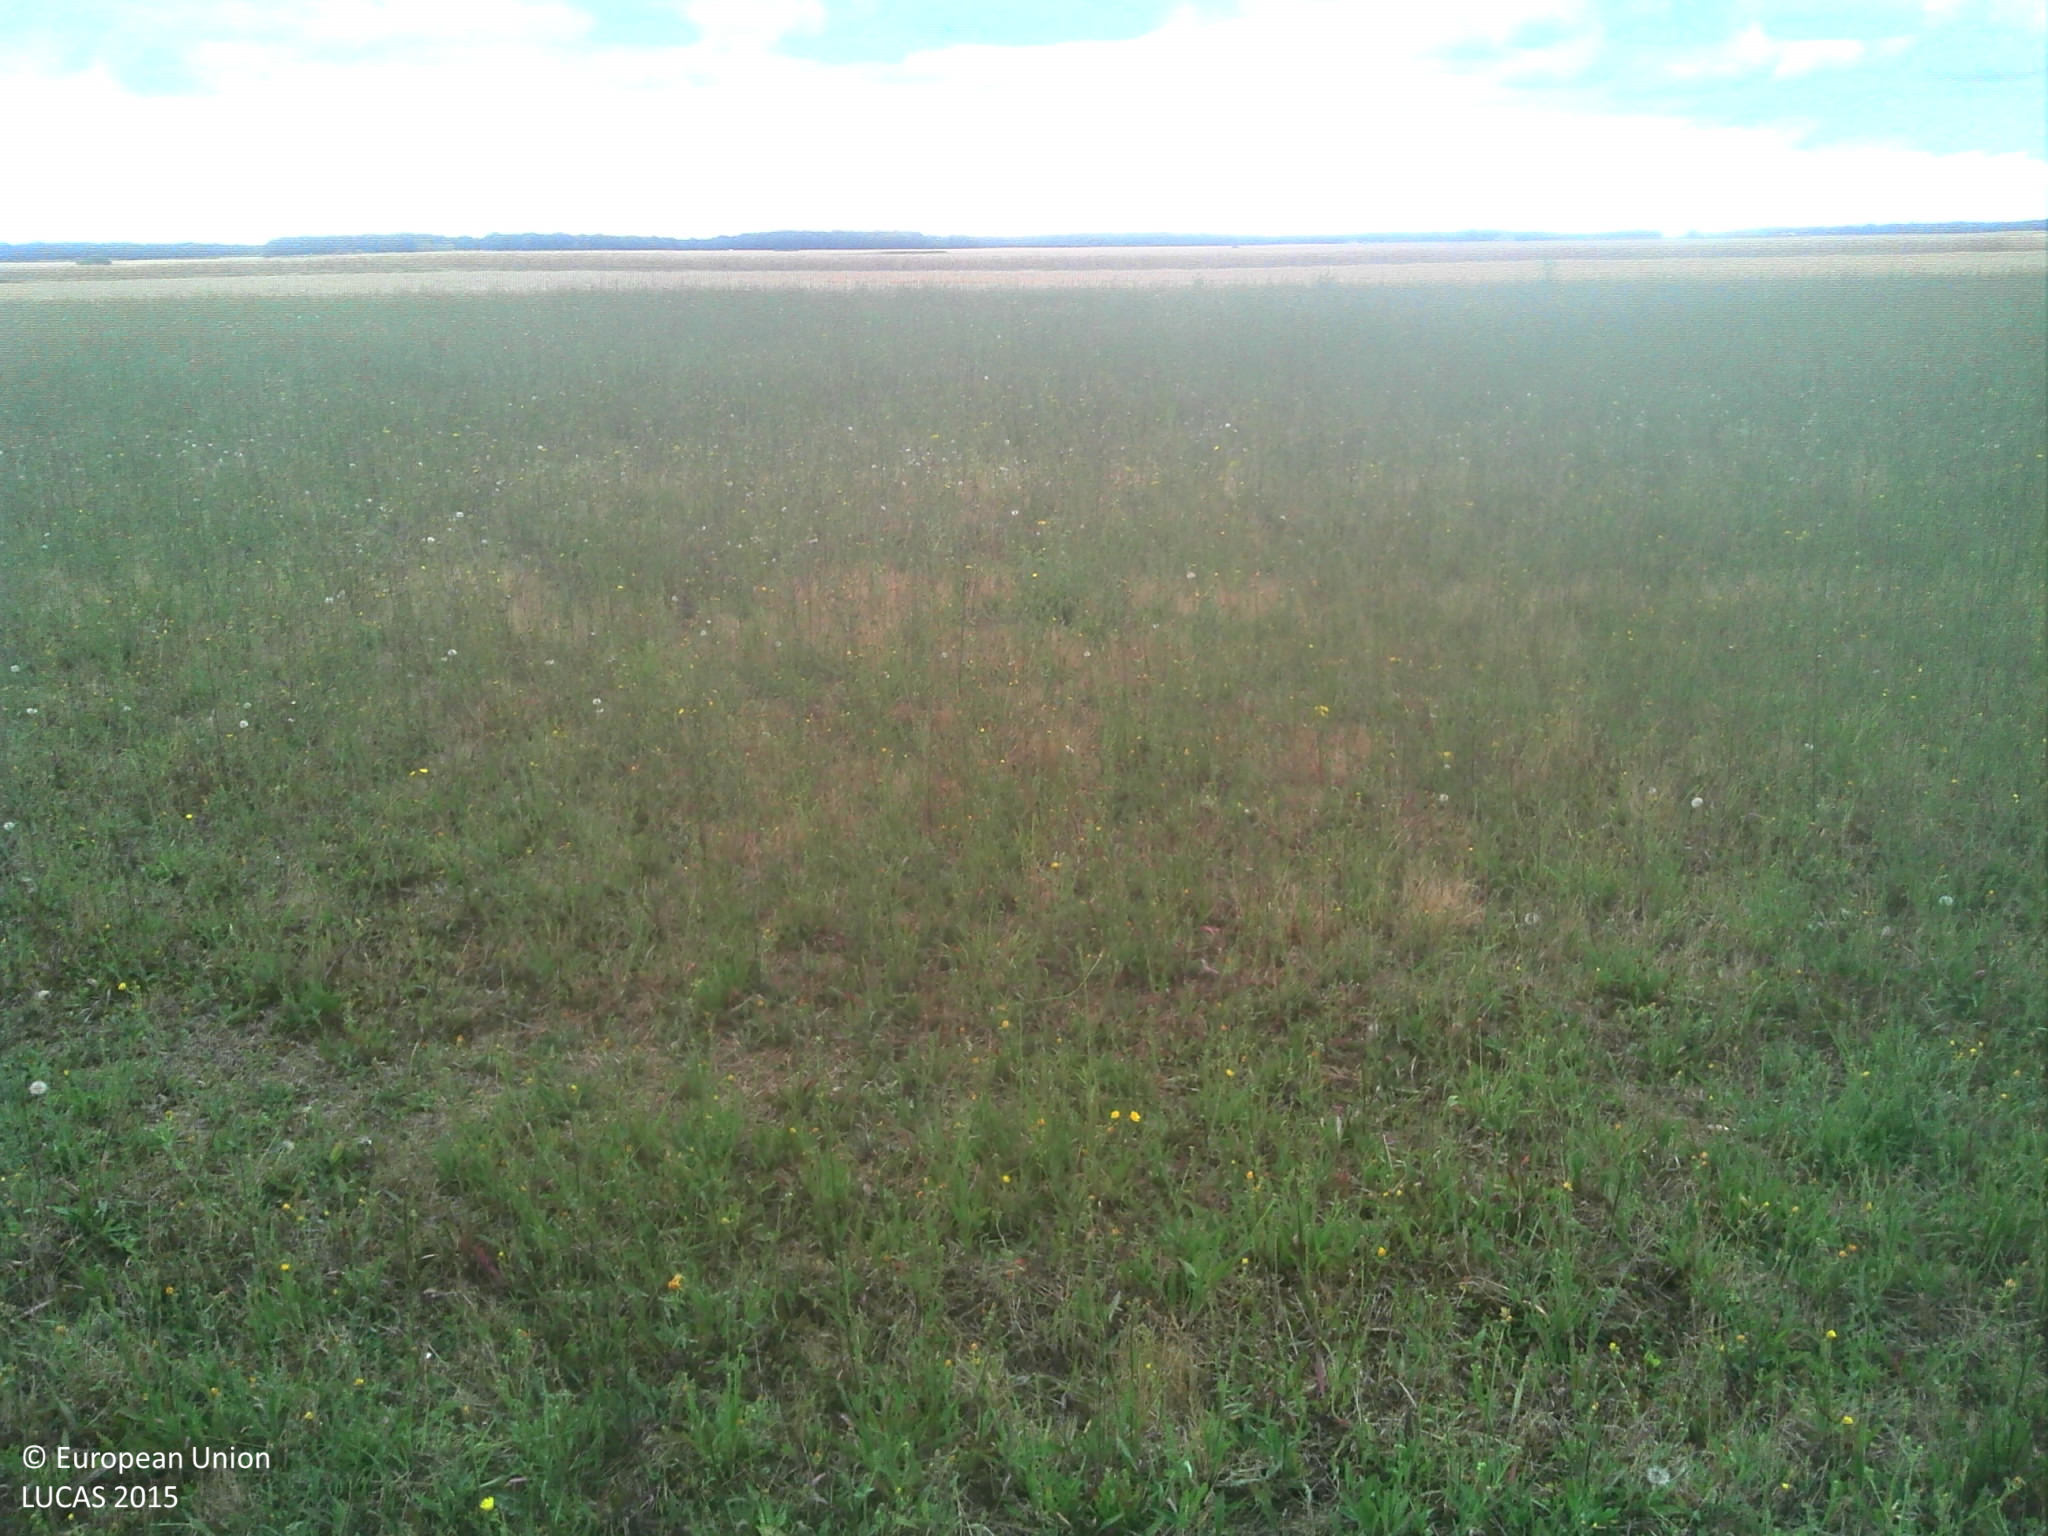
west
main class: Grassland
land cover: Grassland without tree/shrub cover
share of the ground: > 75 %
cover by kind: herbaceous plants 100 %
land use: Semi-natural and natural areas not in use
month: July
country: FR
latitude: 47.8238
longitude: 1.2880
